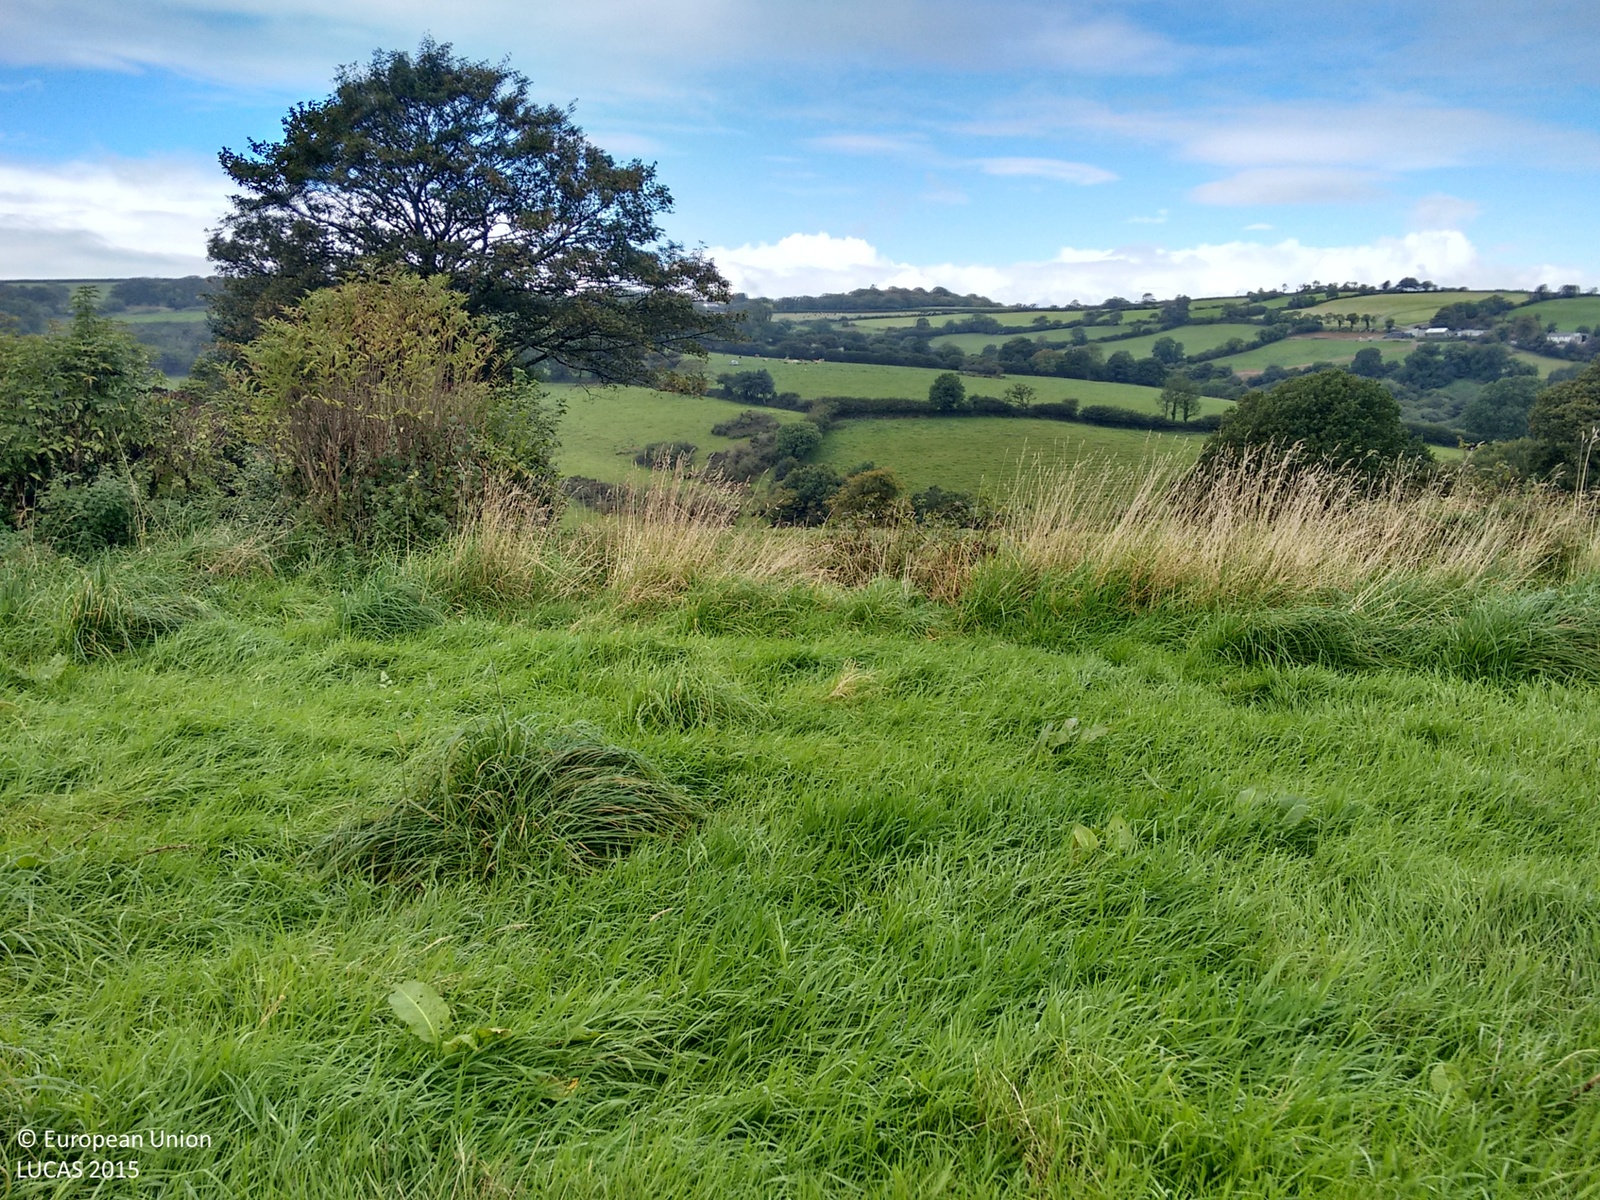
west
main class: Grassland
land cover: Grassland without tree/shrub cover
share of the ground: > 75 %
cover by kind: herbaceous plants 100 %
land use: Agriculture (excluding fallow land and kitchen gardens)
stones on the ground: < 10 %
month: September
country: GB
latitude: 50.6029
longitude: -4.2133
